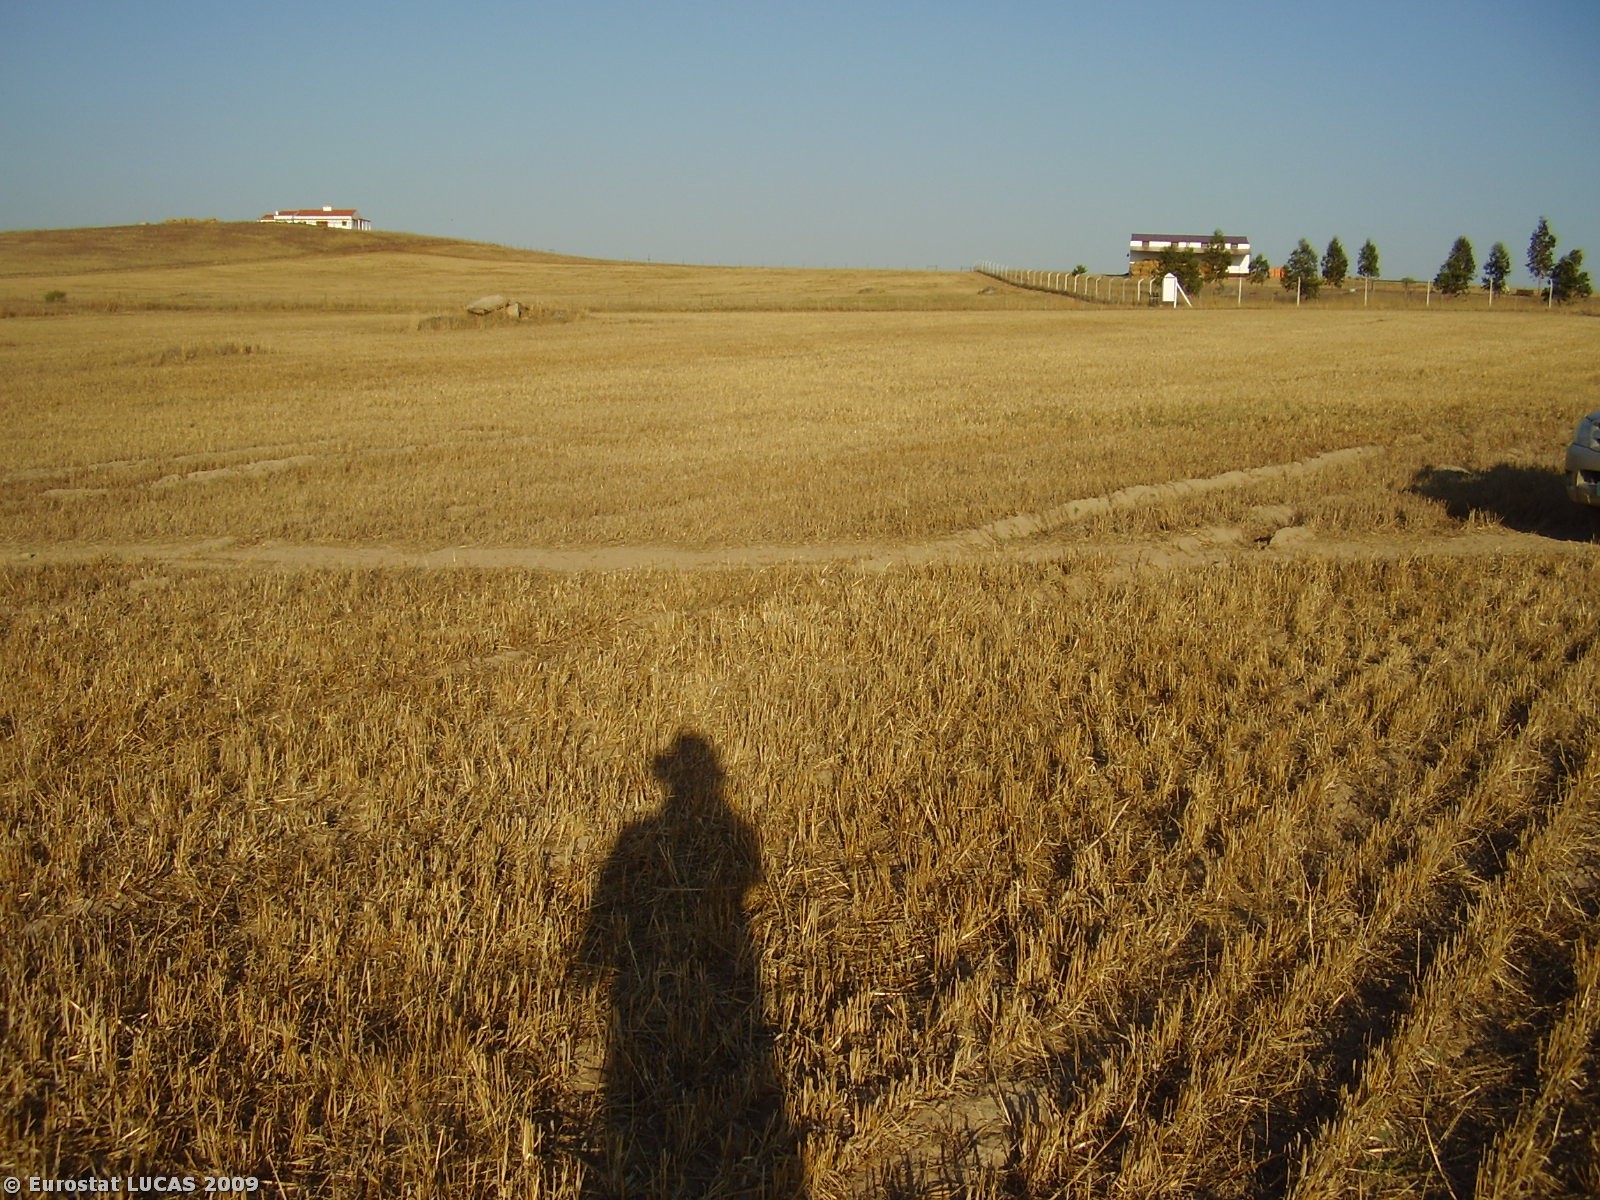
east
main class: Cropland
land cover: Oats
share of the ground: > 75 %
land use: Agriculture (excluding fallow land and kitchen gardens)
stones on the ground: 10 - 25 %
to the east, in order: Oats; Bare land; Grass margins; Fences; Grass margins; Ditches and canals; Tracks; Grass margins; Fences; Spontaneously vegetated surfaces; Fences; Grassland without tree/shrub cover
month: July
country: PT
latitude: 38.6192
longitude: -7.8293
